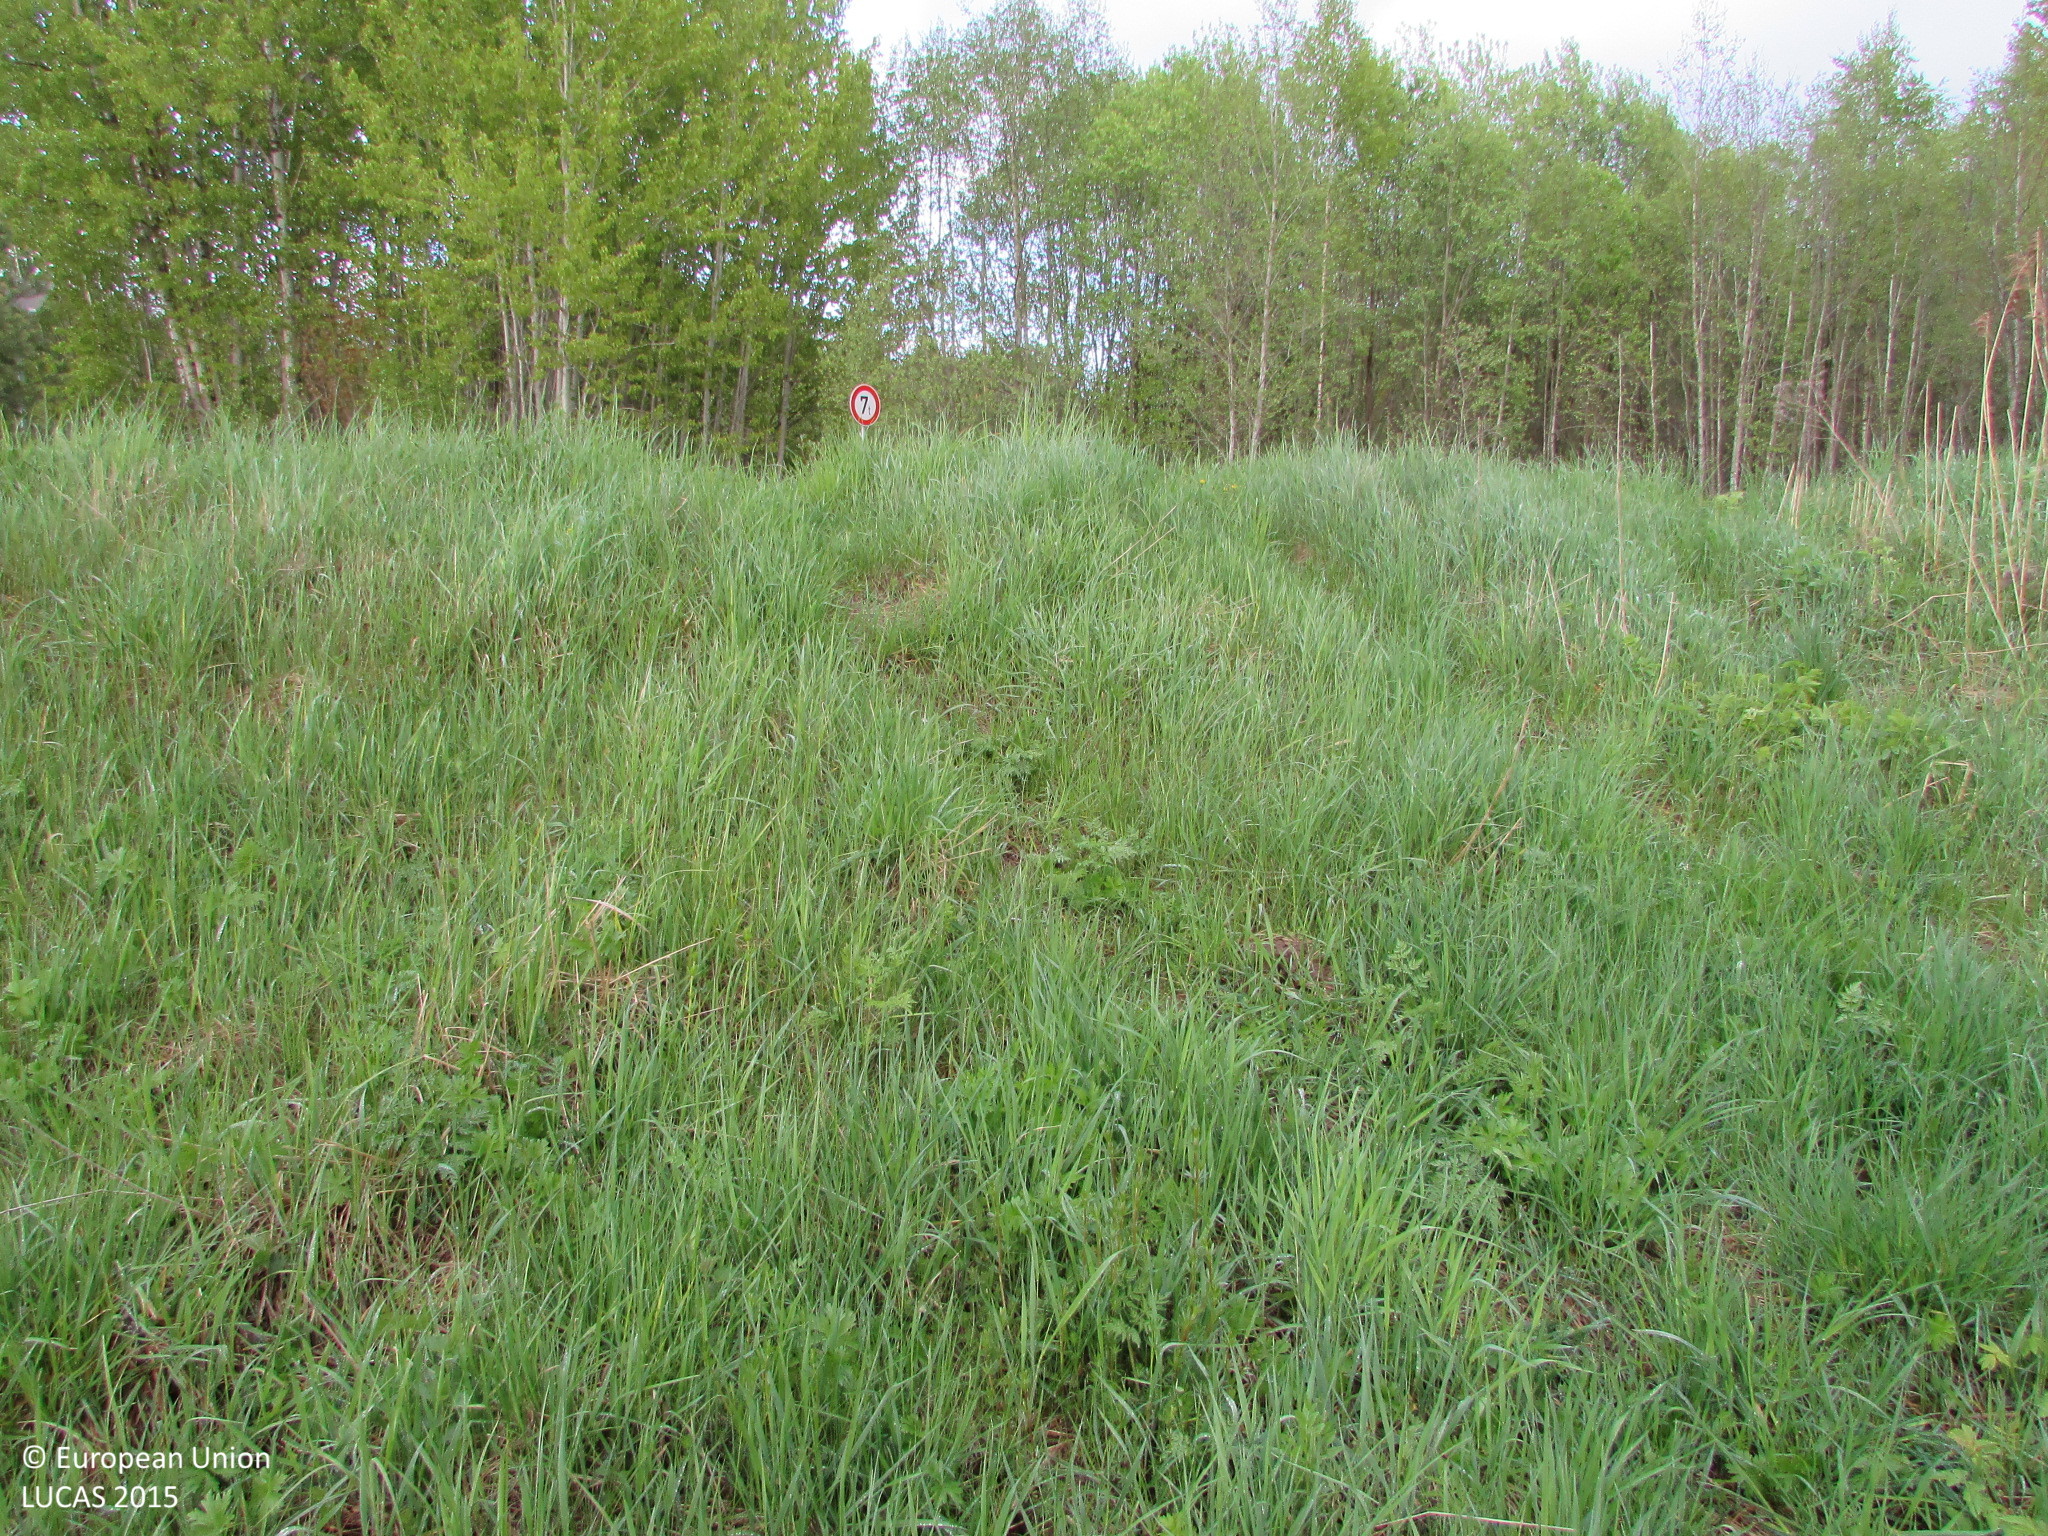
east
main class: Grassland
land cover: Grassland without tree/shrub cover
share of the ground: > 75 %
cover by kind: herbaceous plants 95 %, unconsolidated bare surface 5 %
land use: Agriculture (excluding fallow land and kitchen gardens)
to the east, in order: Grassland without tree/shrub cover; Paved roads, cycling and walking lanes; Grassland without tree/shrub cover; Broadleaved woodland; Grassland with sparse tree/shrub cover; Broadleaved woodland; Pine dominated coniferous woodland; Grassland with sparse tree/shrub cover; Grassland without tree/shrub cover
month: May
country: LV
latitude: 56.2270
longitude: 27.2203
